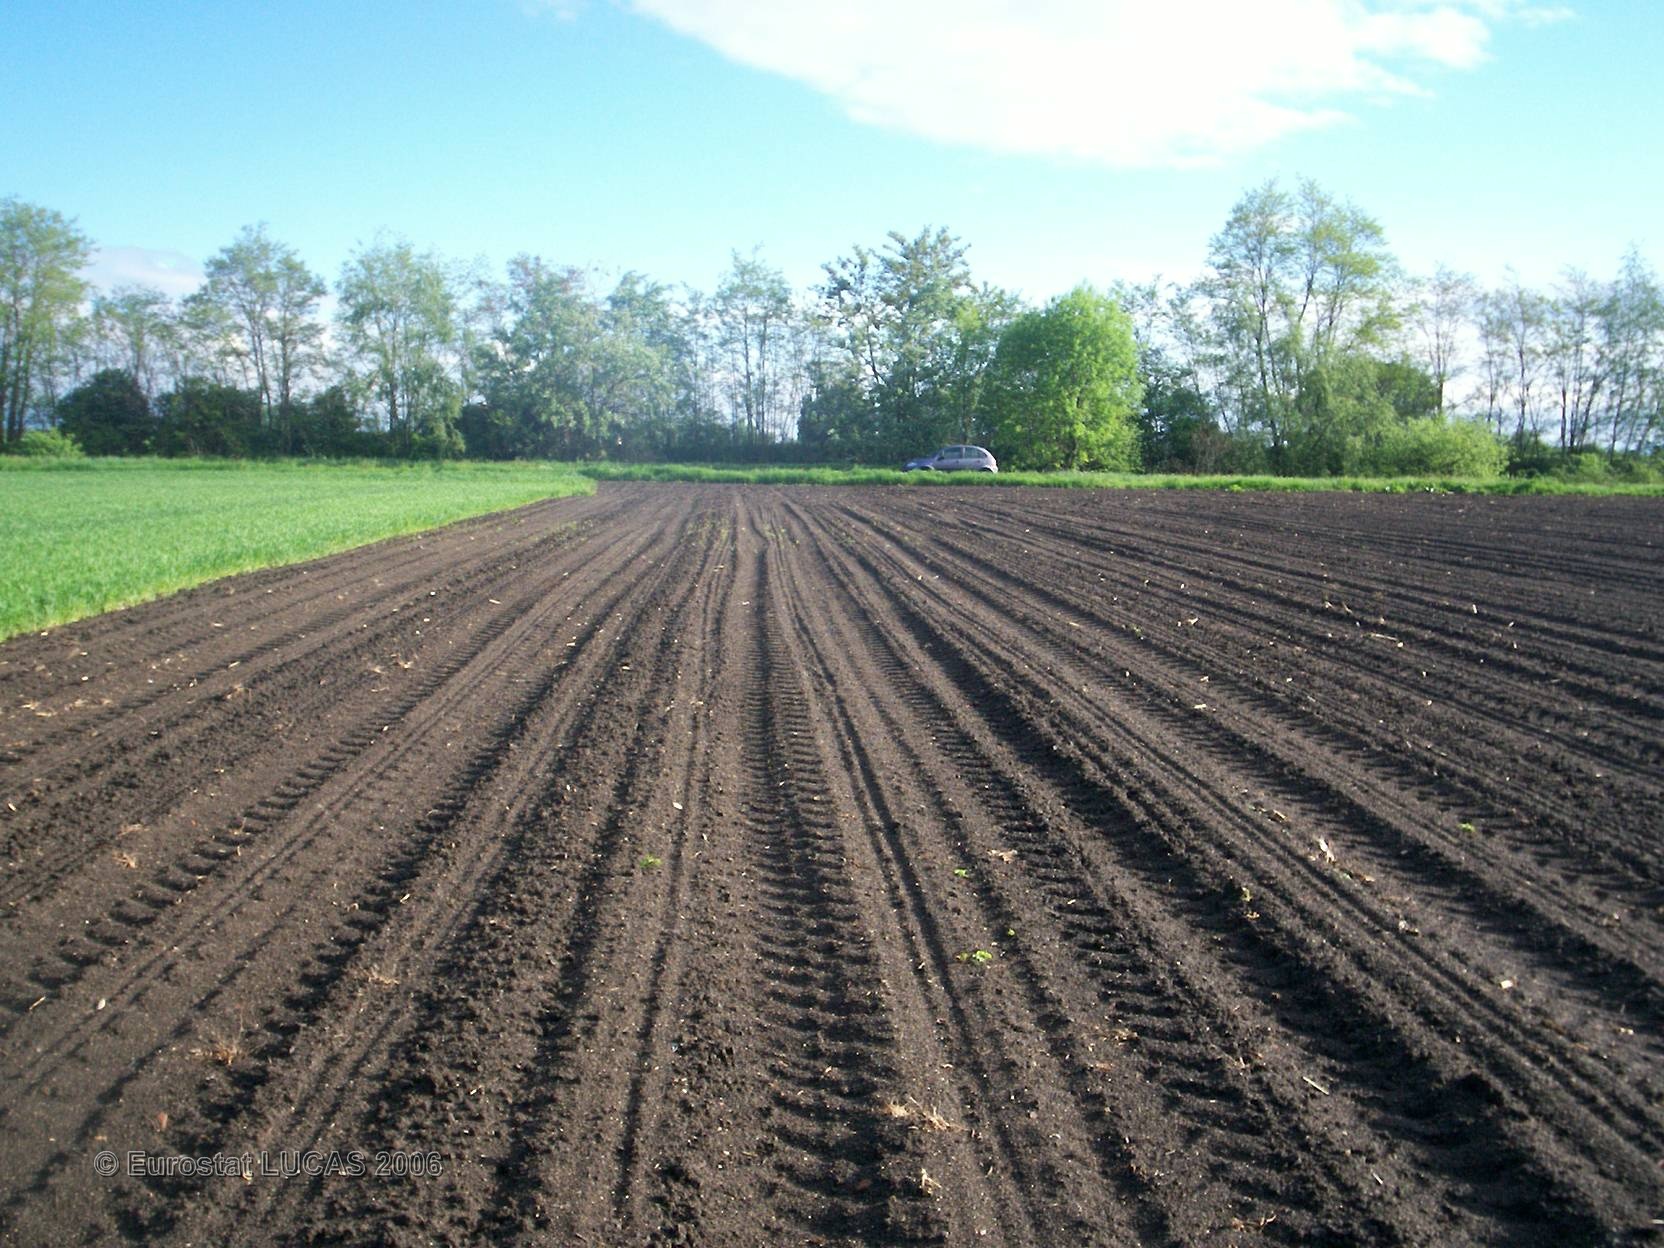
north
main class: Cropland
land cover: Maize
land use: Agriculture (excluding fallow land and kitchen gardens)
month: May
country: FR
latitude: 45.8252
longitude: 3.1648
